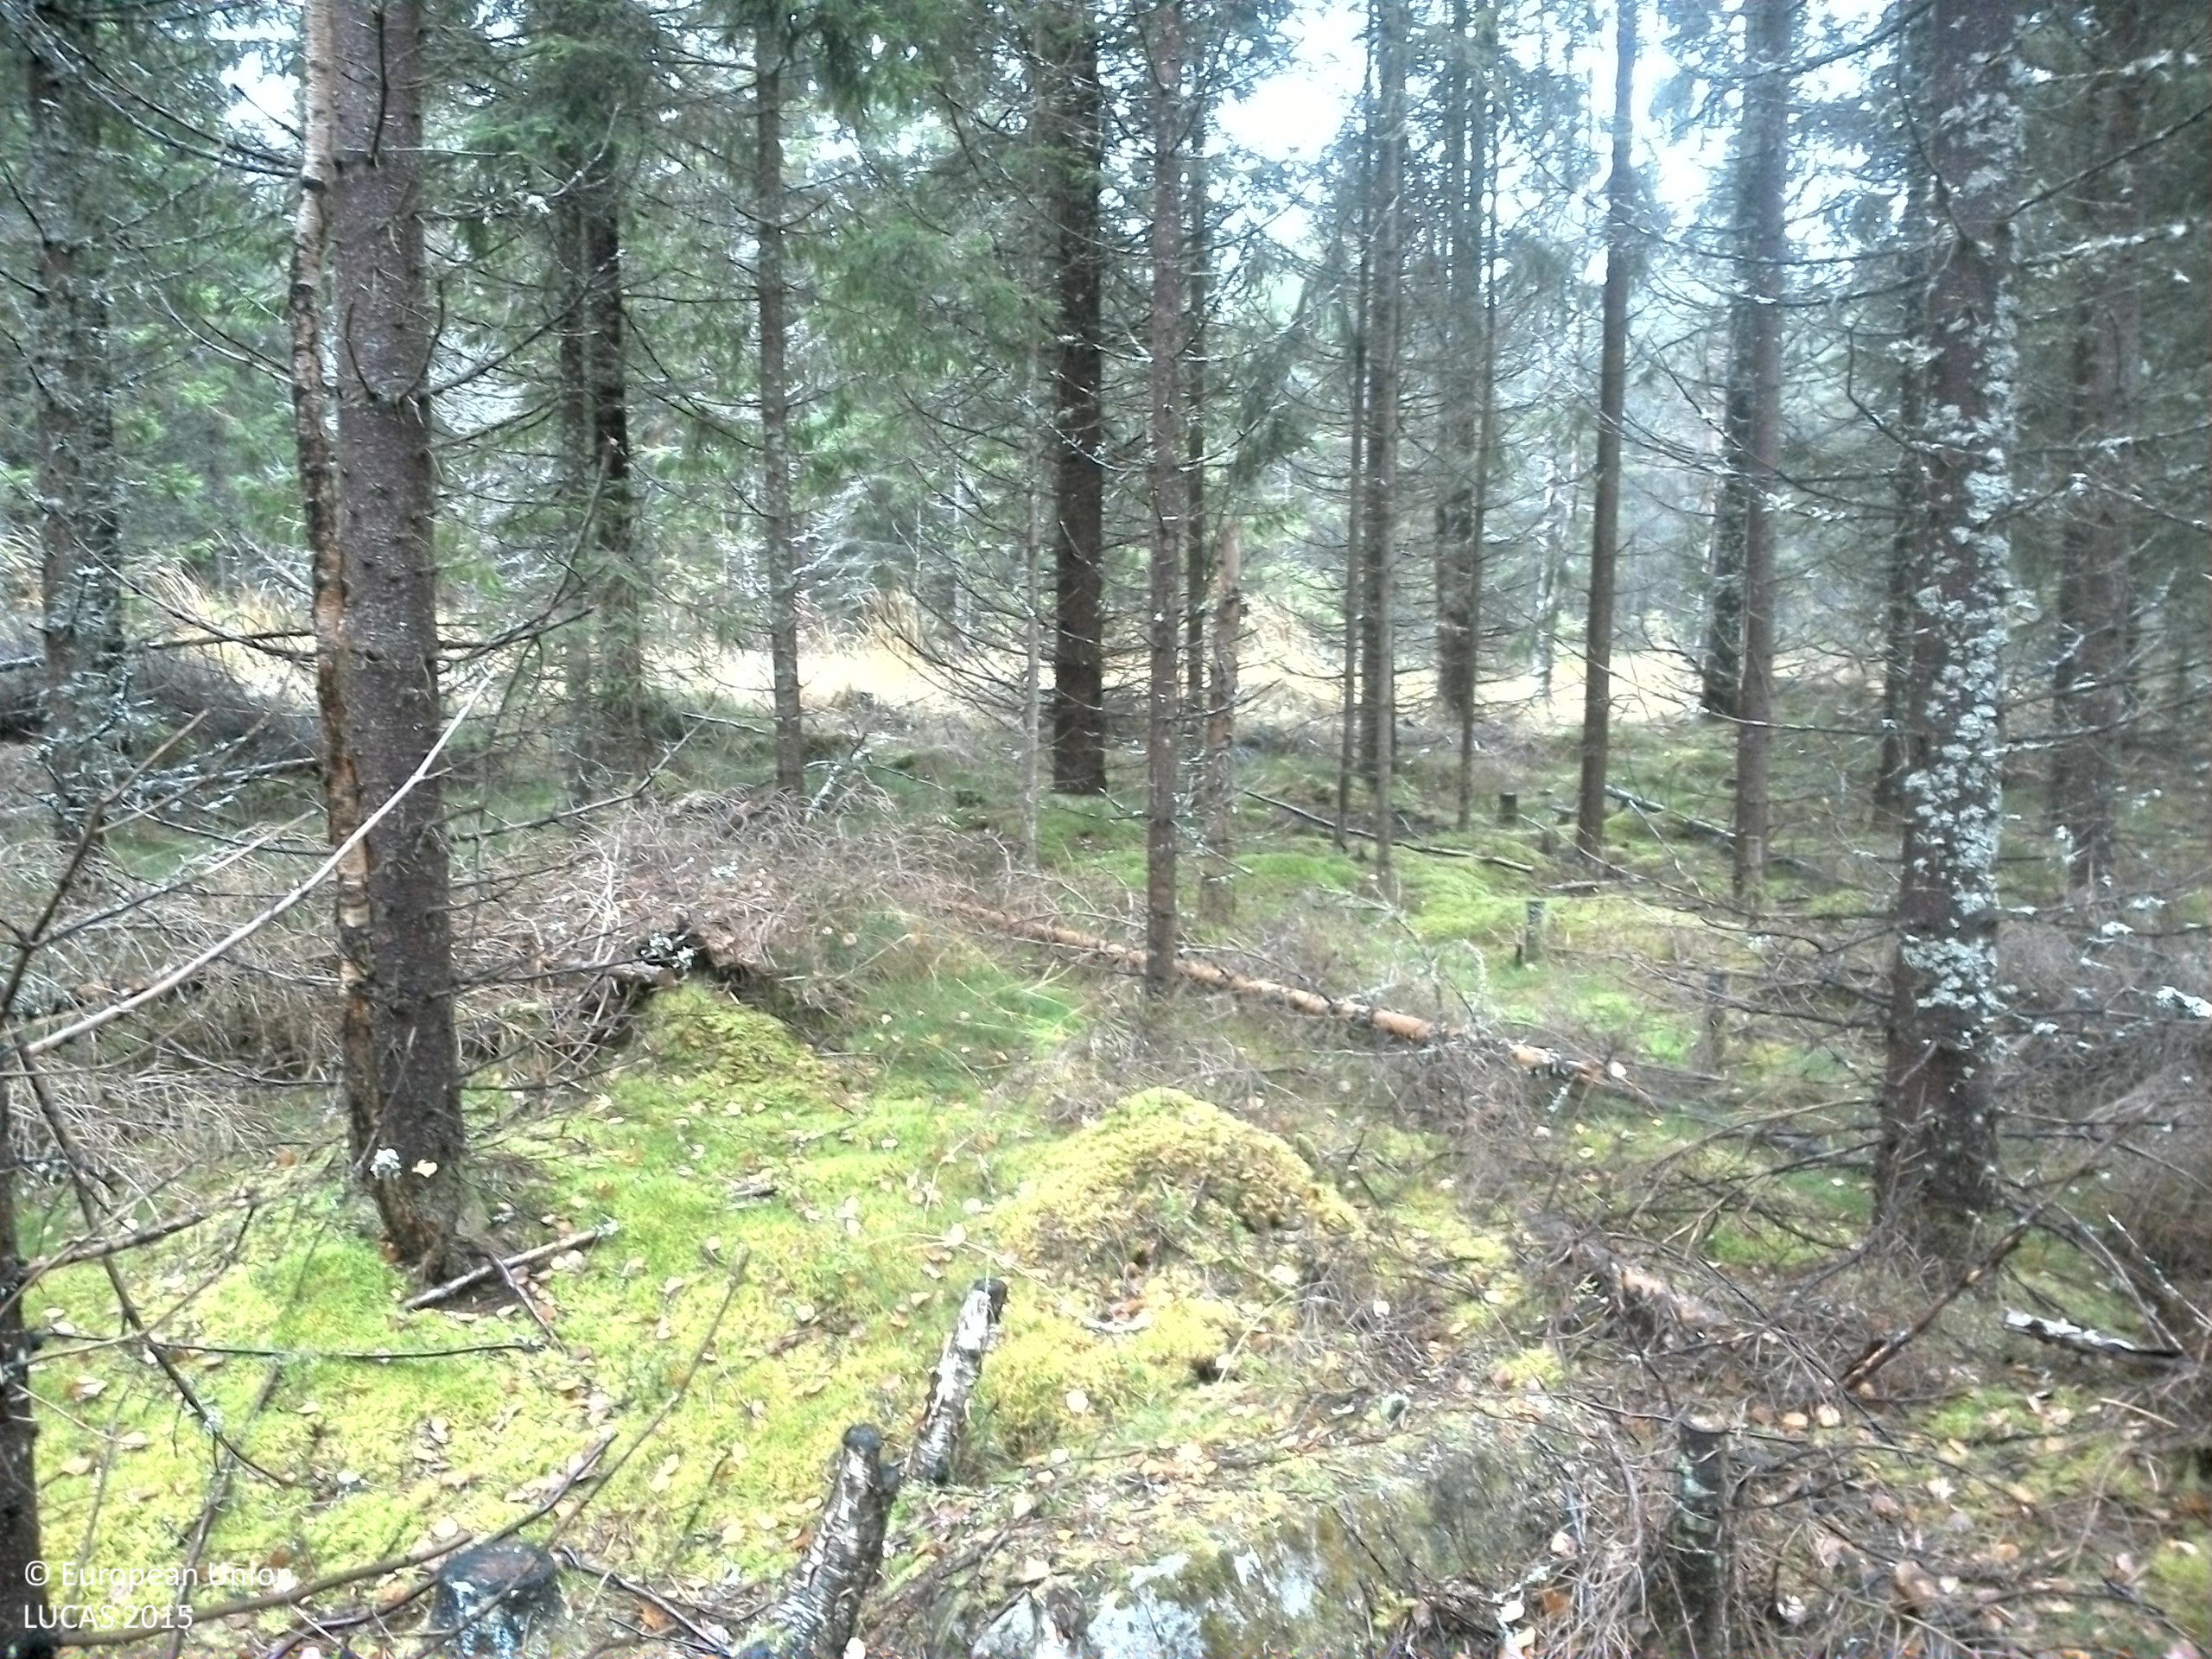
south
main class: Woodland
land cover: Spruce dominated coniferous woodland
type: boreal forest
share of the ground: 50 - 75 %
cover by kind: coniferous forest trees 55 %, shrubs 15 %, herbaceous plants 15 %, lichens and mosses 15 %
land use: Forestry
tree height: > 5 m
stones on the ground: 10 - 25 %
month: October
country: SE
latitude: 59.7714
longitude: 14.8871
